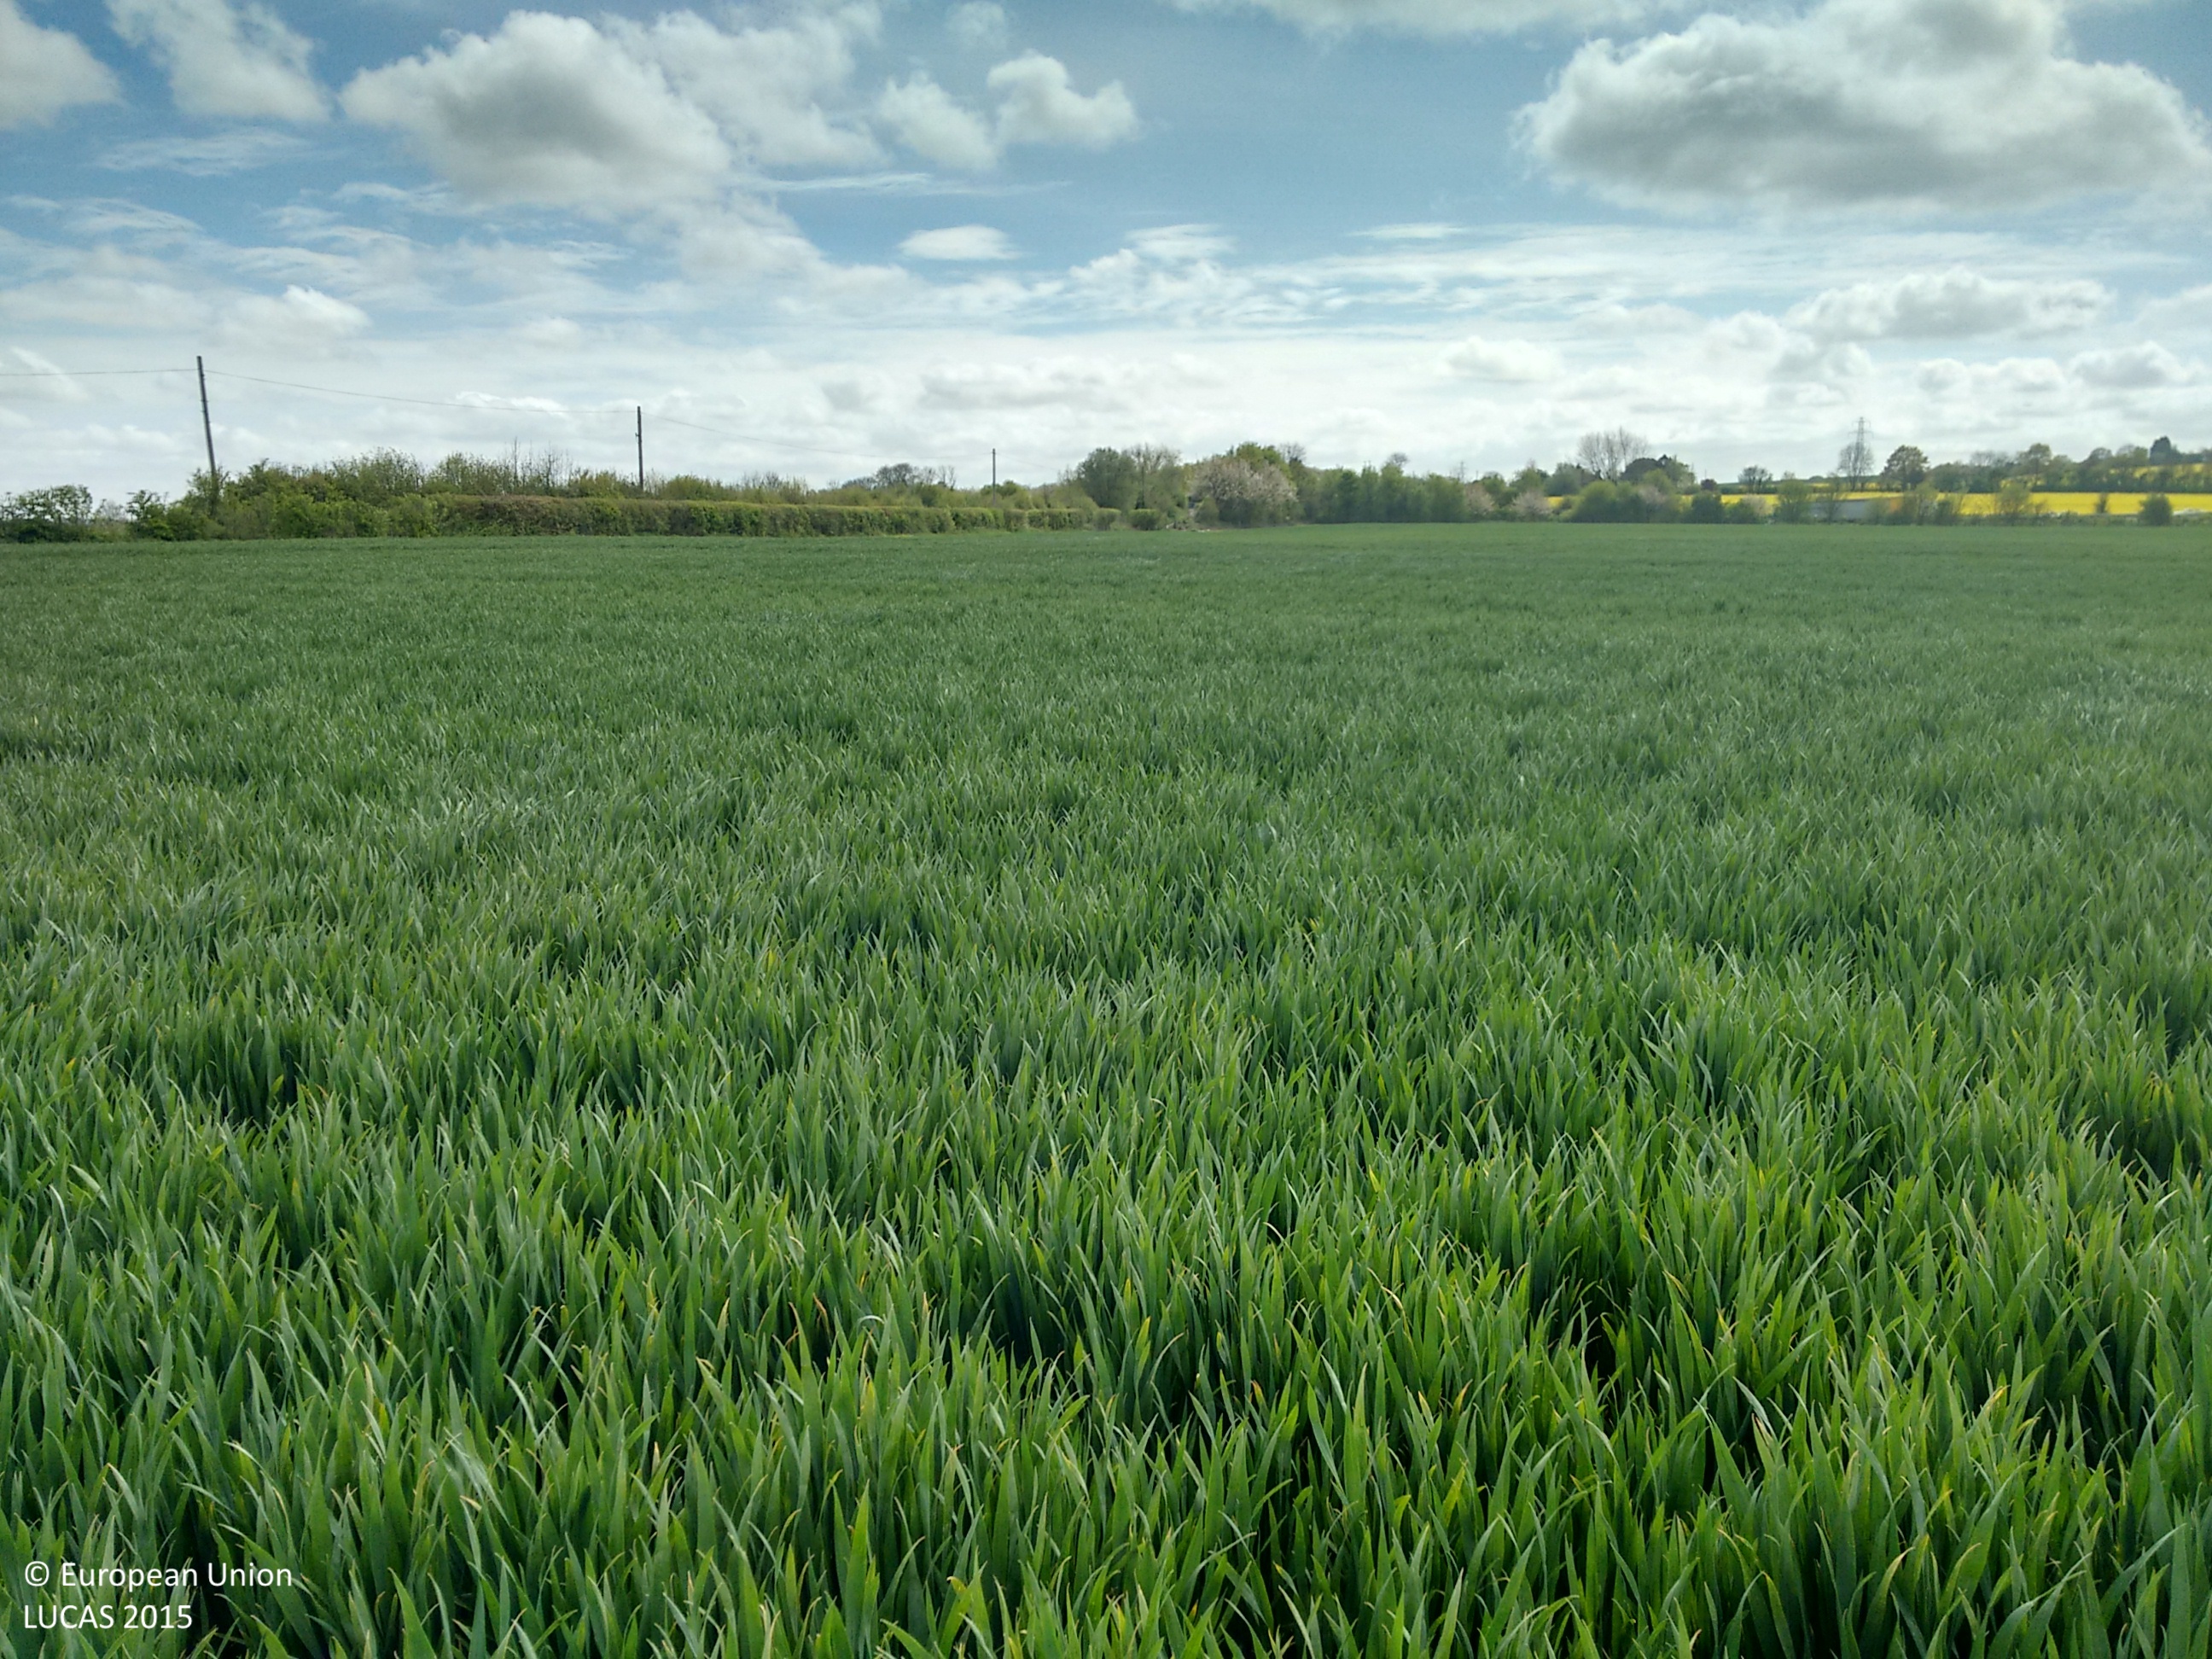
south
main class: Cropland
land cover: Common wheat
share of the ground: > 75 %
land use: Agriculture (excluding fallow land and kitchen gardens)
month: May
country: GB
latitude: 51.3231
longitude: 0.6895
